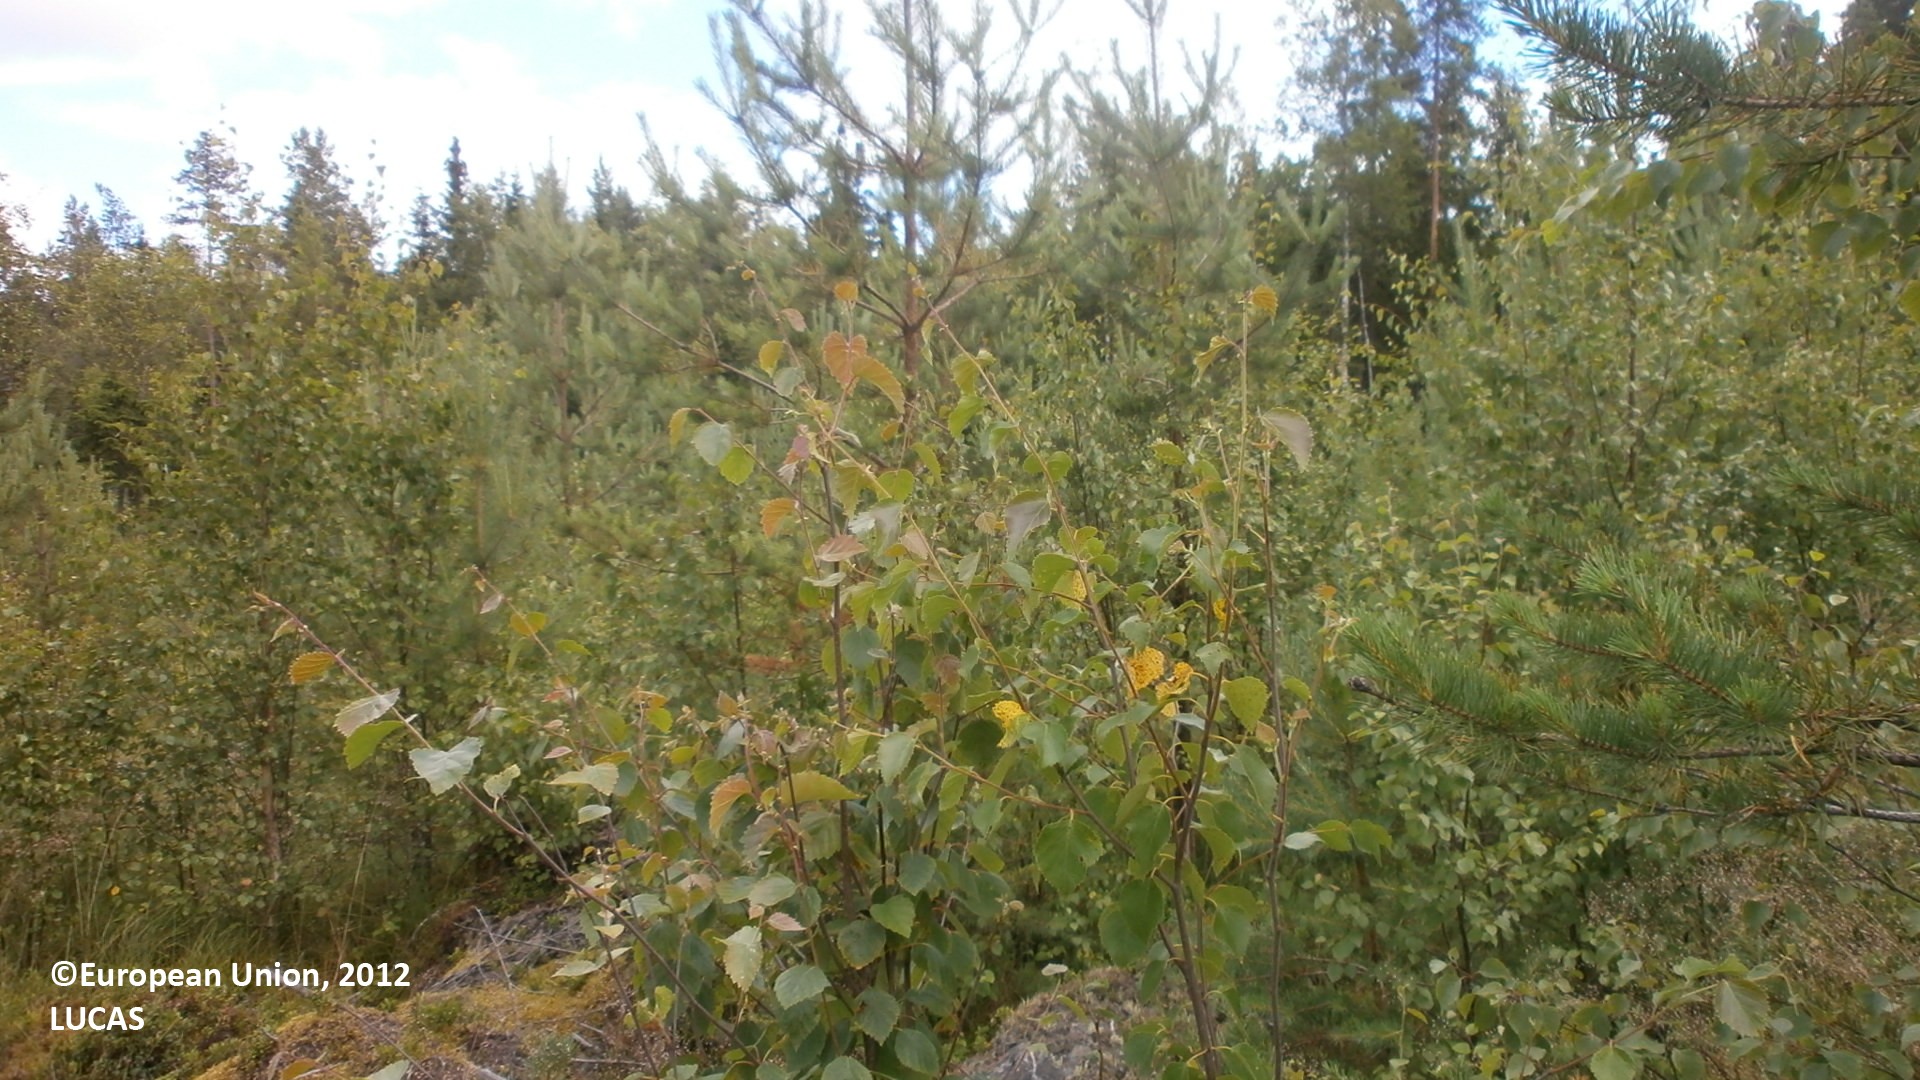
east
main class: Woodland
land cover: Pine dominated mixed woodland
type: boreal forest
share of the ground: 50 - 75 %
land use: Forestry
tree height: > 5 m
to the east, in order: Pine dominated mixed woodland; Spruce dominated mixed woodland; Ditches and canals; Spruce dominated mixed woodland; Spruce dominated coniferous woodland; Ditches and canals; Spruce dominated mixed woodland; Ditches and canals; Grassland with sparse tree/shrub cover; Ditches and canals; Shruby margins; Temporary grasslands
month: July
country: FI
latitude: 64.0134
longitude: 23.7873
